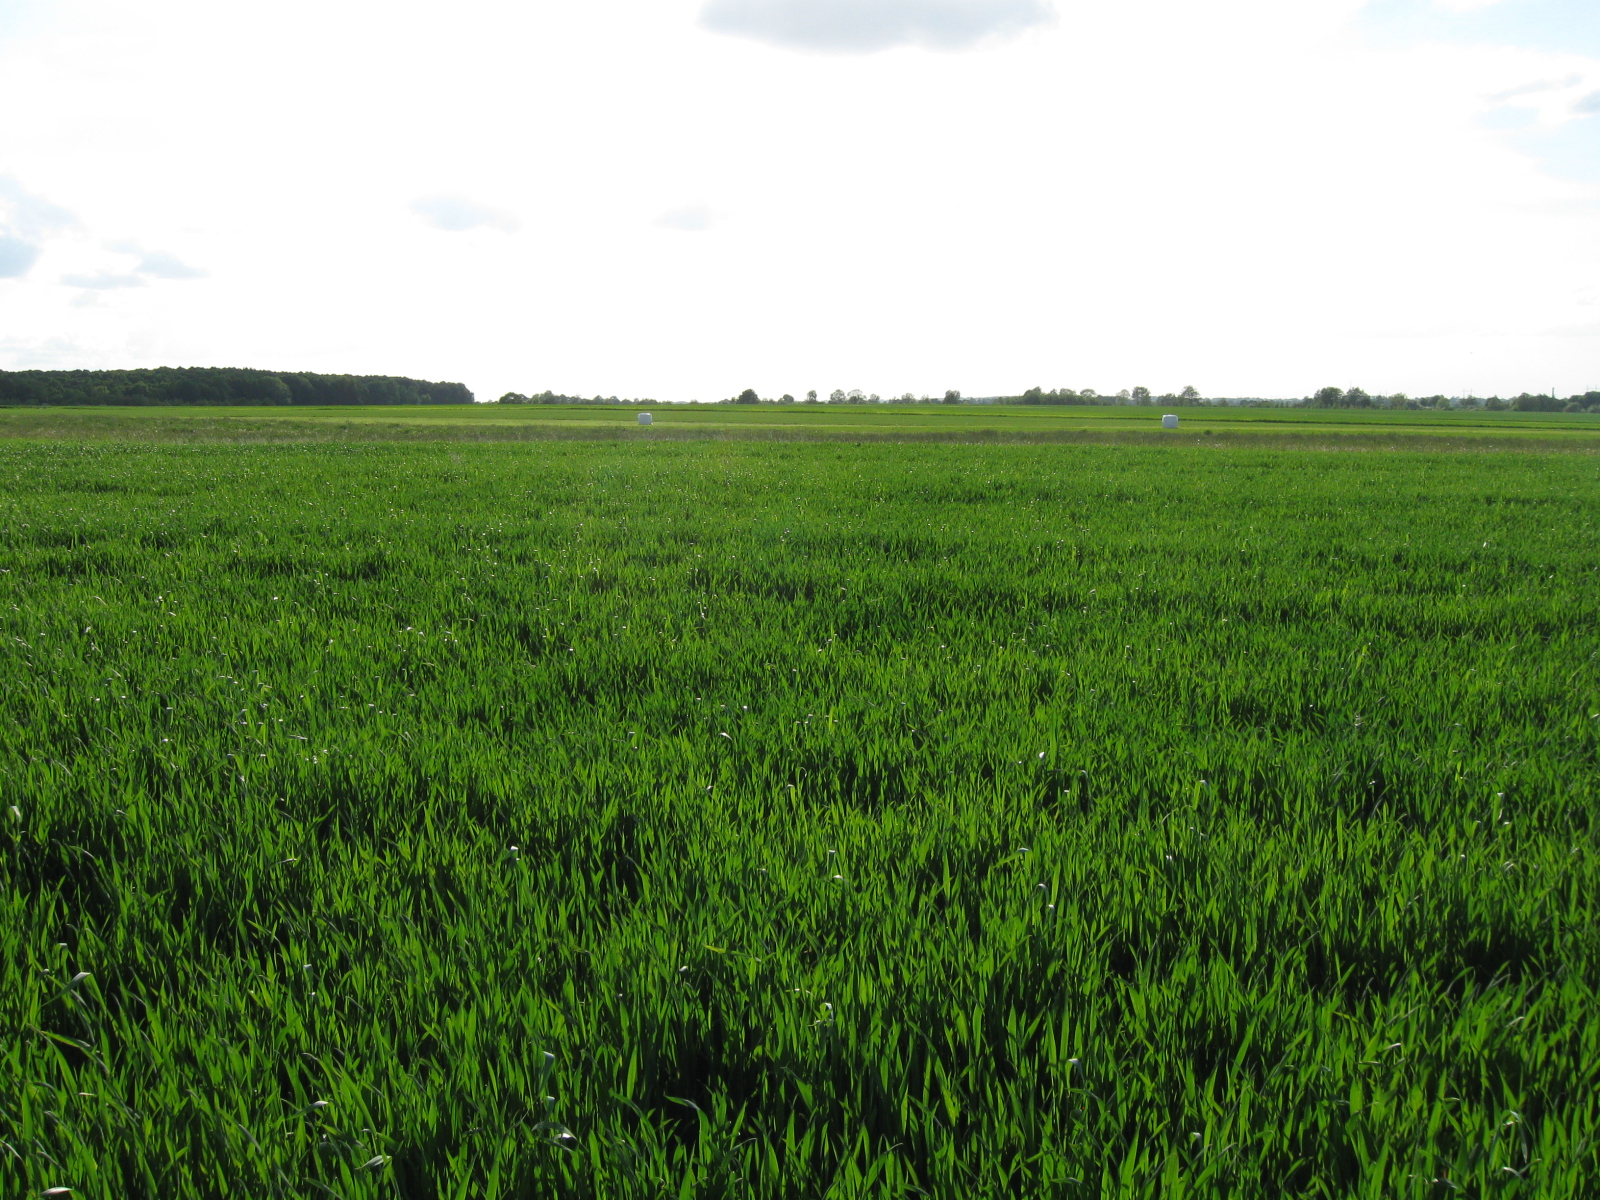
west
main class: Cropland
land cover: Common wheat
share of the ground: > 75 %
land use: Agriculture (excluding fallow land and kitchen gardens)
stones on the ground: < 10 %
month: May
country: LT
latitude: 54.6125
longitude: 22.8122
